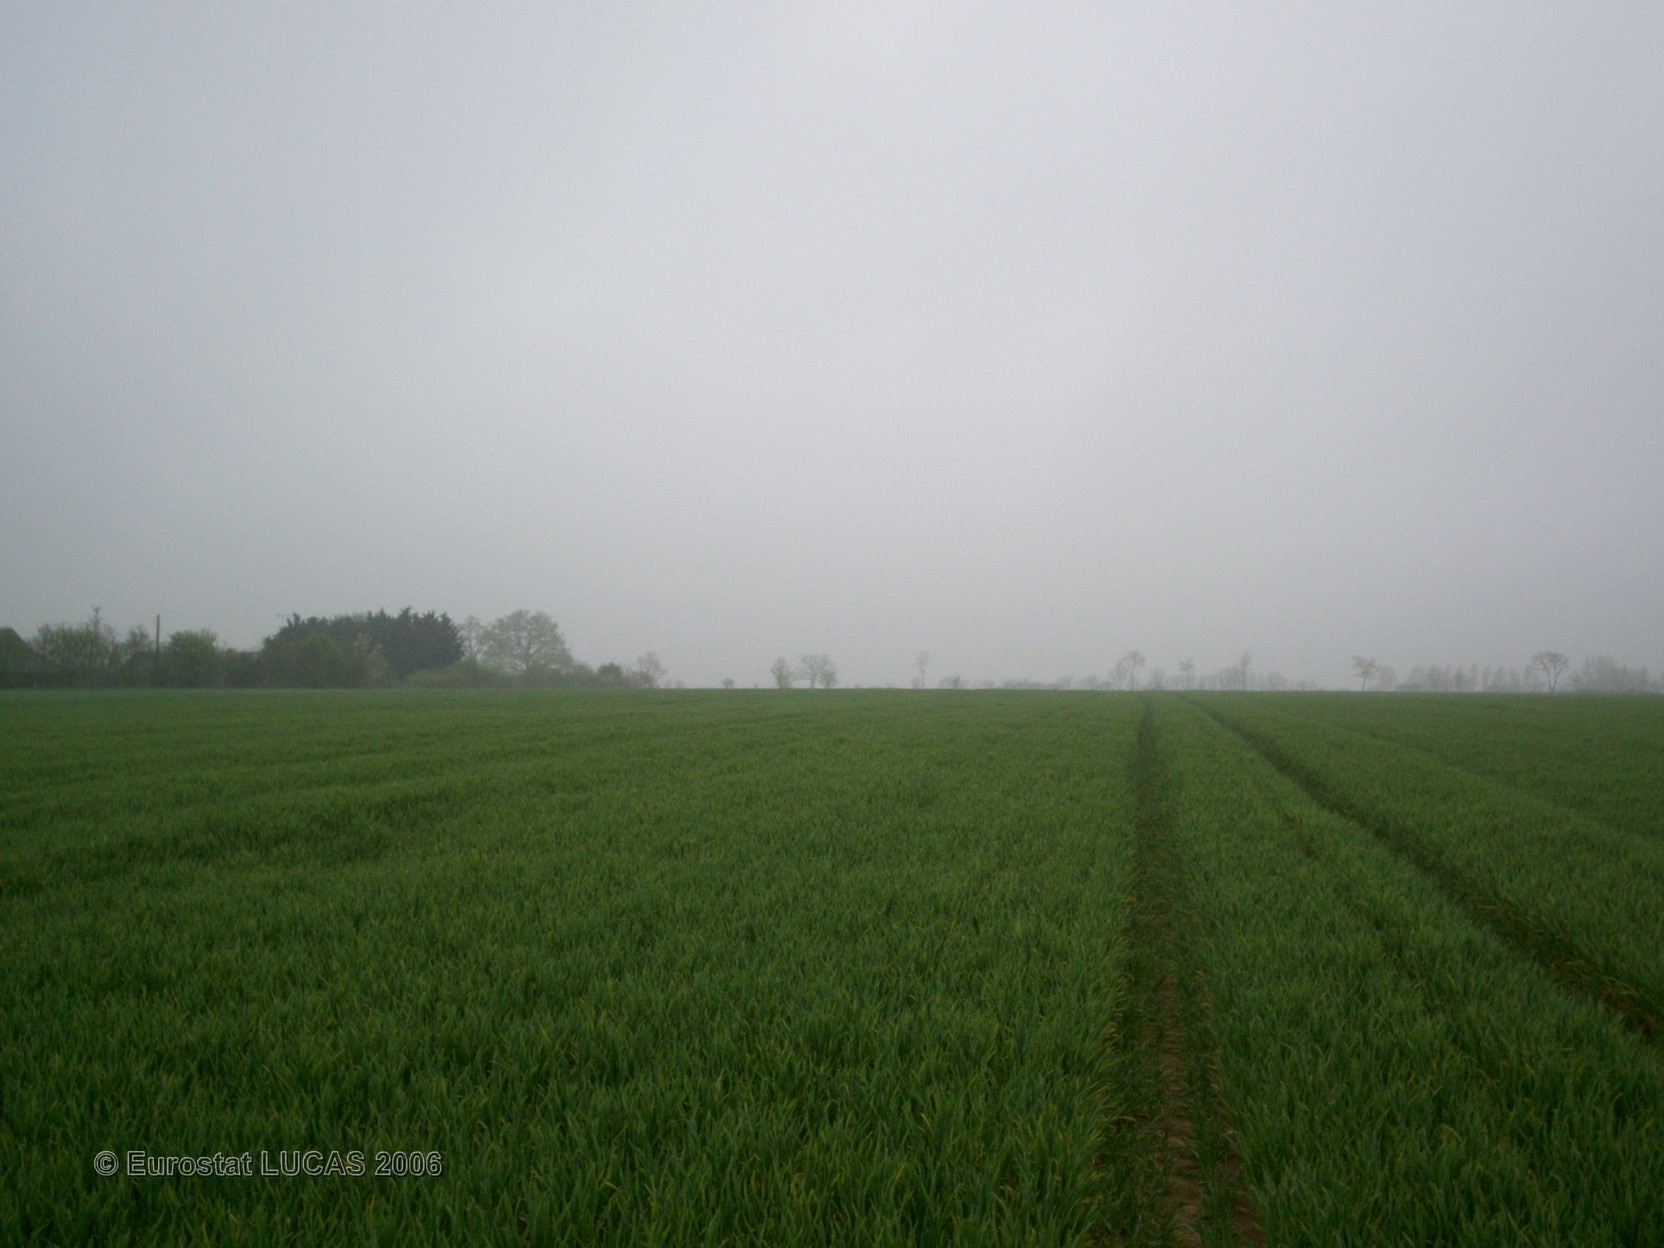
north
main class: Cropland
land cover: Common wheat
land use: Agriculture (excluding fallow land and kitchen gardens)
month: April
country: FR
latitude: 48.2316
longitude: -0.6579
